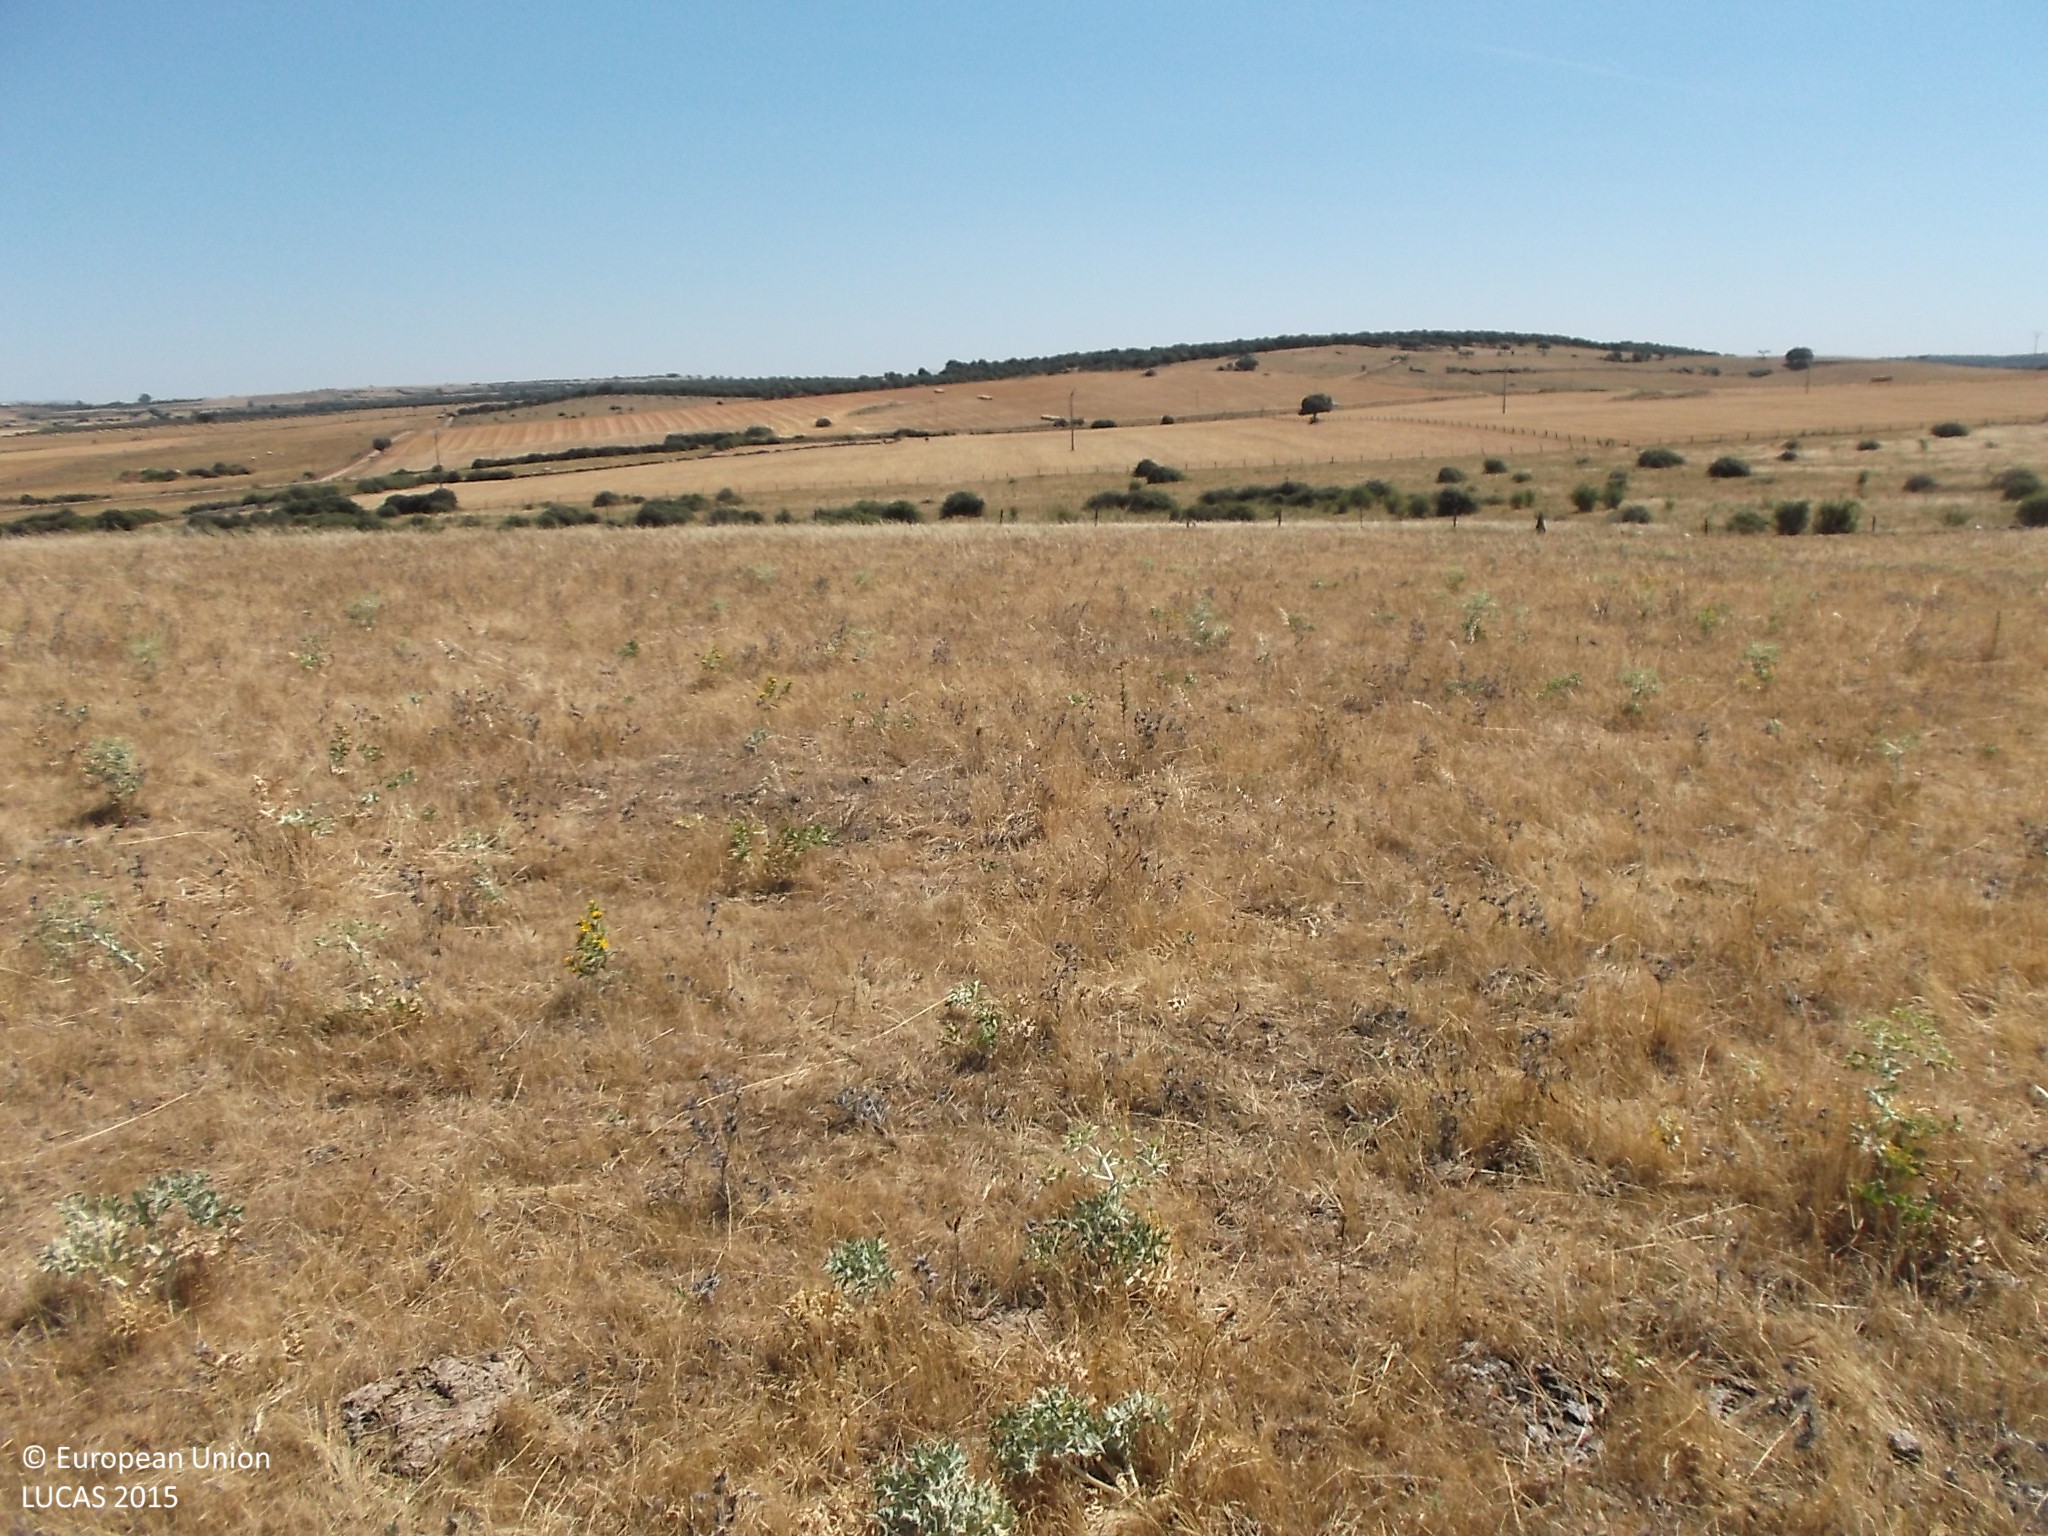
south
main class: Grassland
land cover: Grassland without tree/shrub cover
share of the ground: > 75 %
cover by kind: herbaceous plants 100 %
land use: Agriculture (excluding fallow land and kitchen gardens)
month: July
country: ES
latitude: 40.7309
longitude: -6.7564
